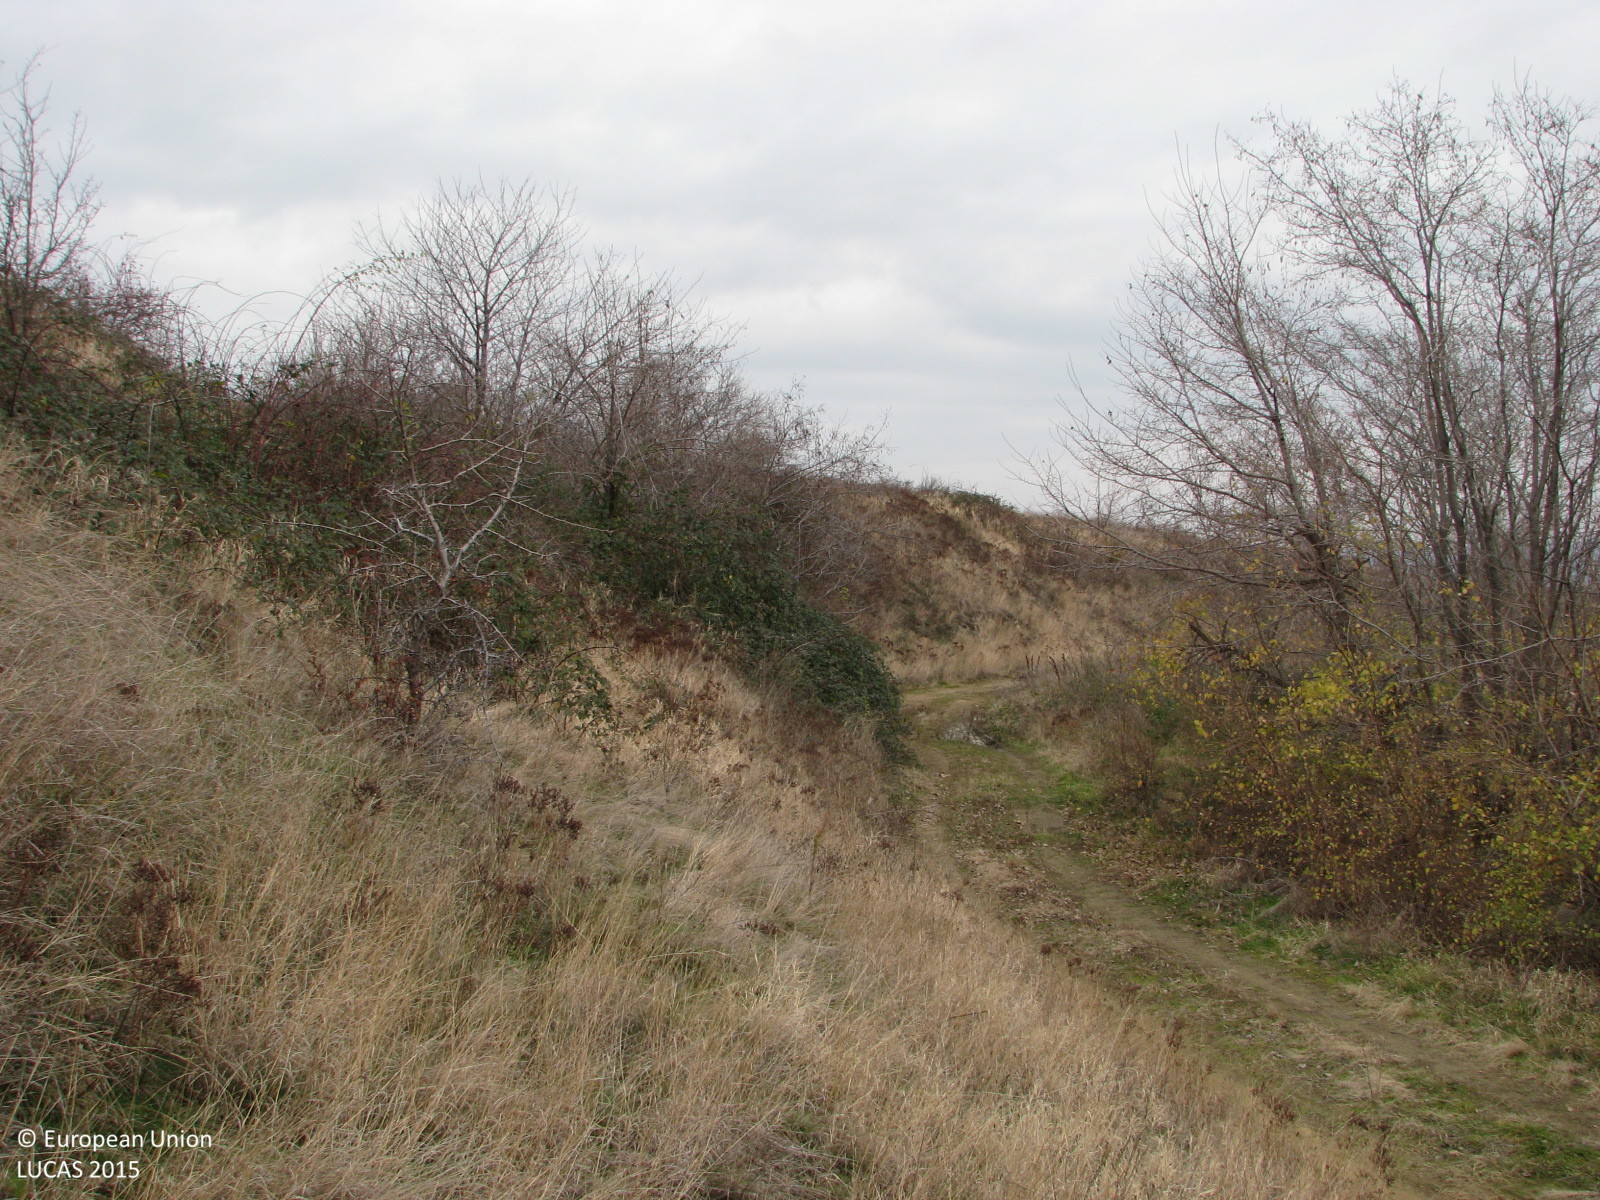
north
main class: Grassland
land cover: Grassland with sparse tree/shrub cover
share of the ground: > 75 %
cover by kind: herbaceous plants 80 %, broadleaved forest trees 5 %, shrubs 5 %, lichens and mosses 5 %, unconsolidated bare surface 5 %
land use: Semi-natural and natural areas not in use
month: December
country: BG
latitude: 42.3304
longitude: 24.0339
